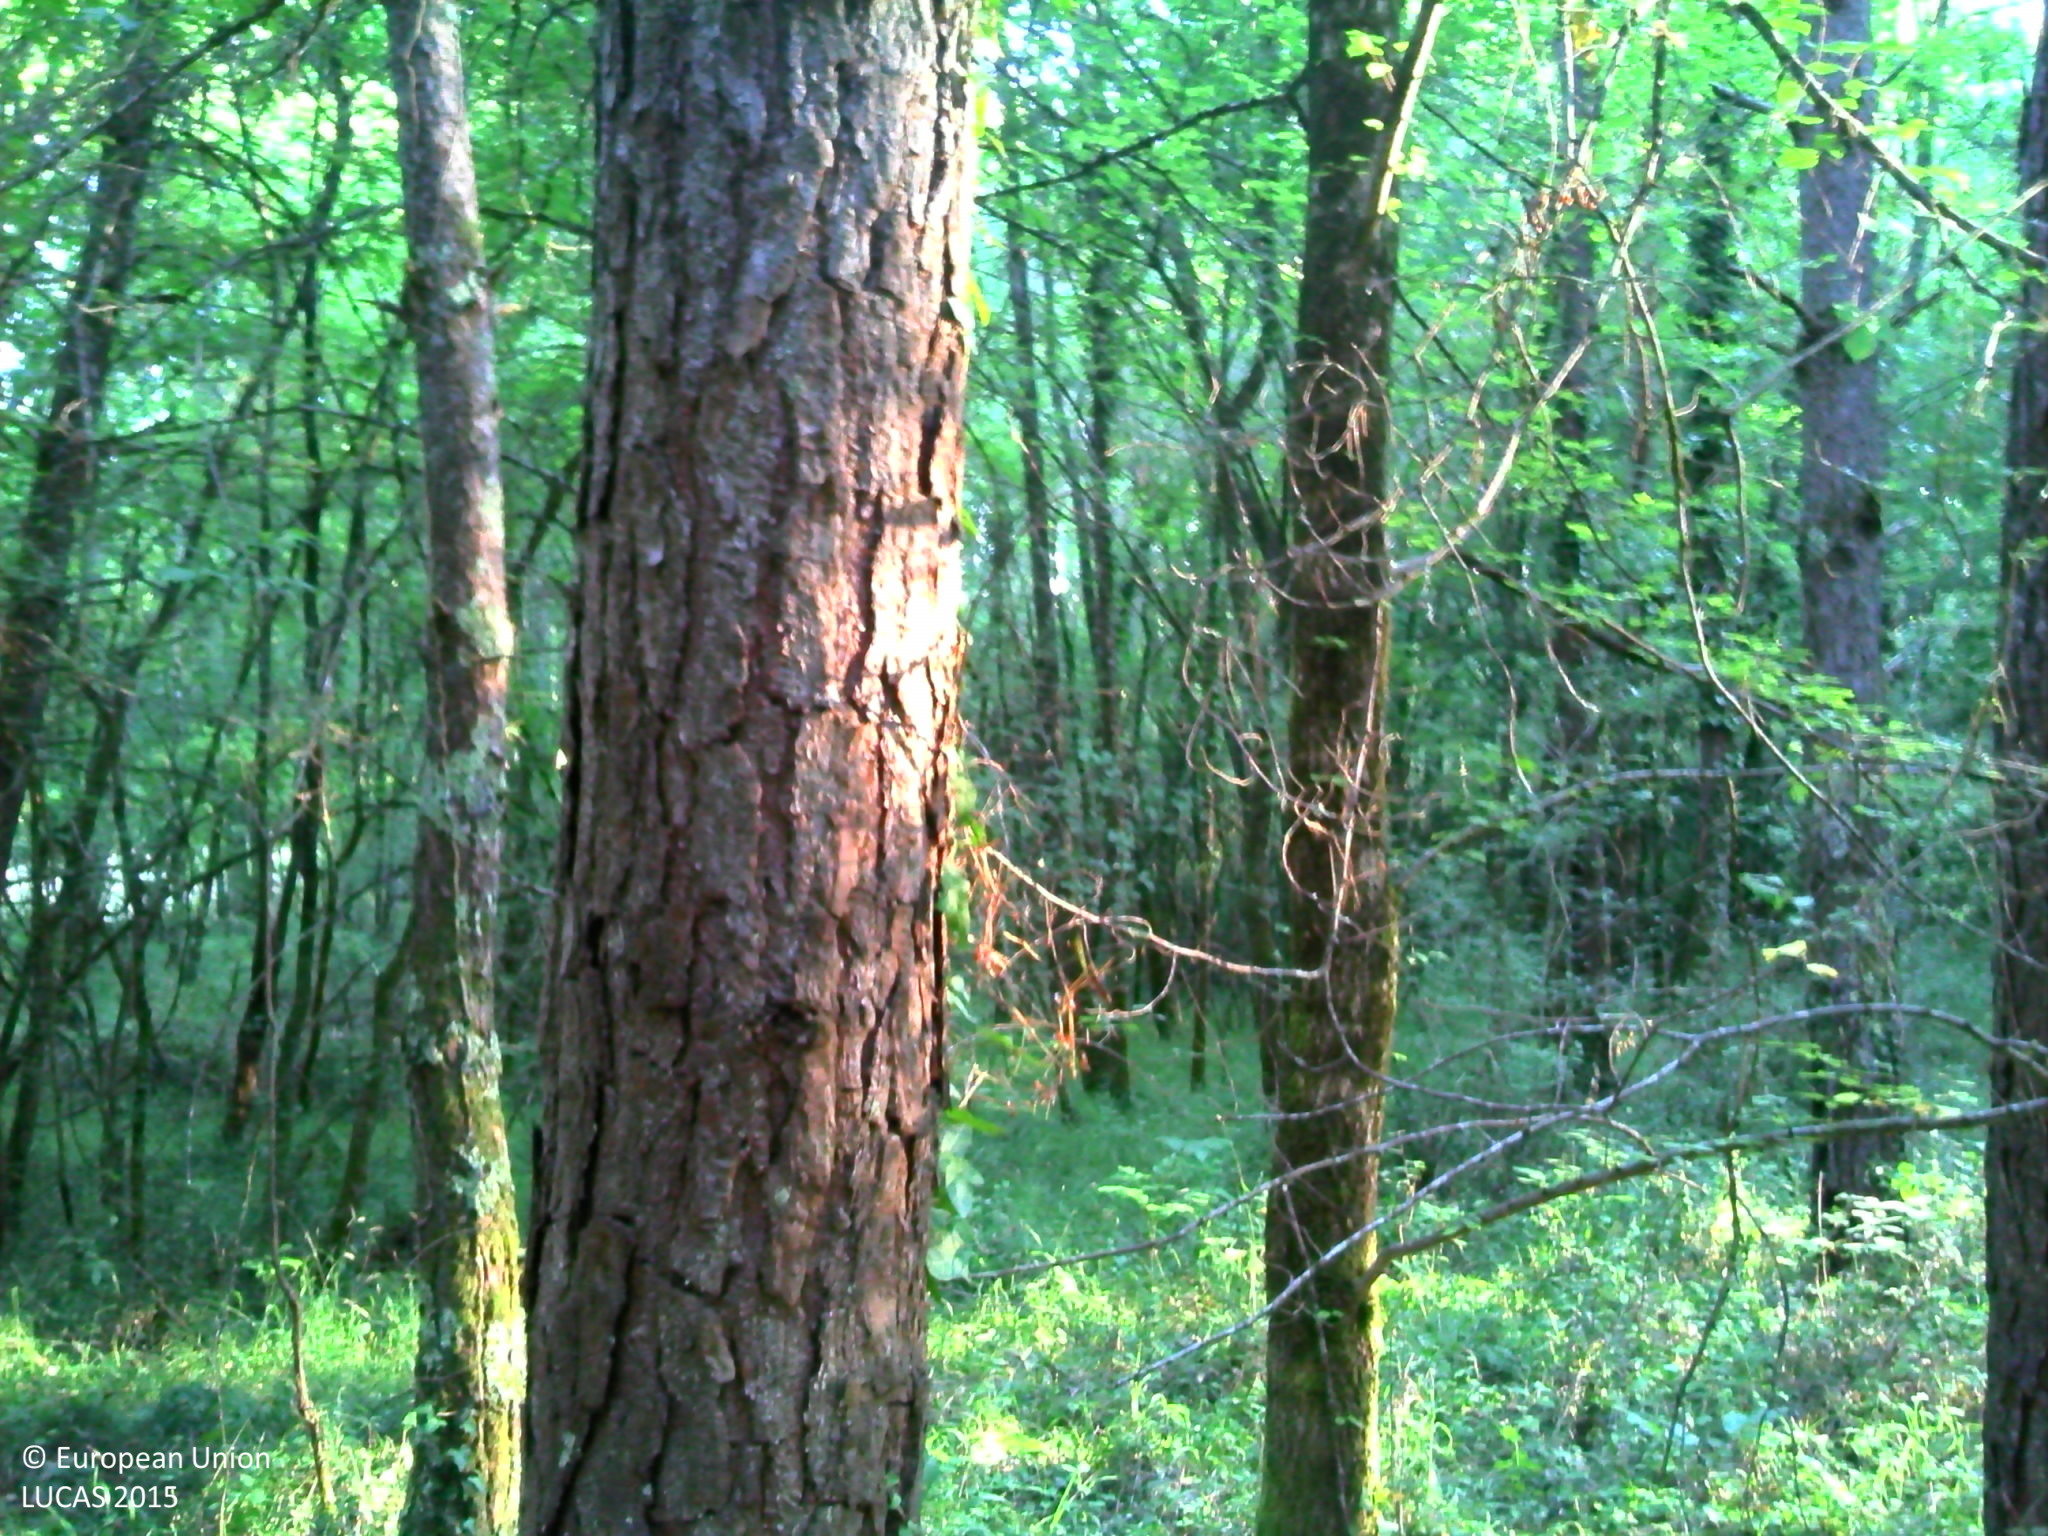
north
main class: Woodland
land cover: Pine dominated mixed woodland
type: mesophytic deciduous forest
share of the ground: > 75 %
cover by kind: broadleaved forest trees 60 %, coniferous forest trees 20 %, herbaceous plants 10 %, shrubs 5 %, lichens and mosses 5 %
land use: Forestry
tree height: > 5 m
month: August
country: FR
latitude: 44.8297
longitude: 0.7970
